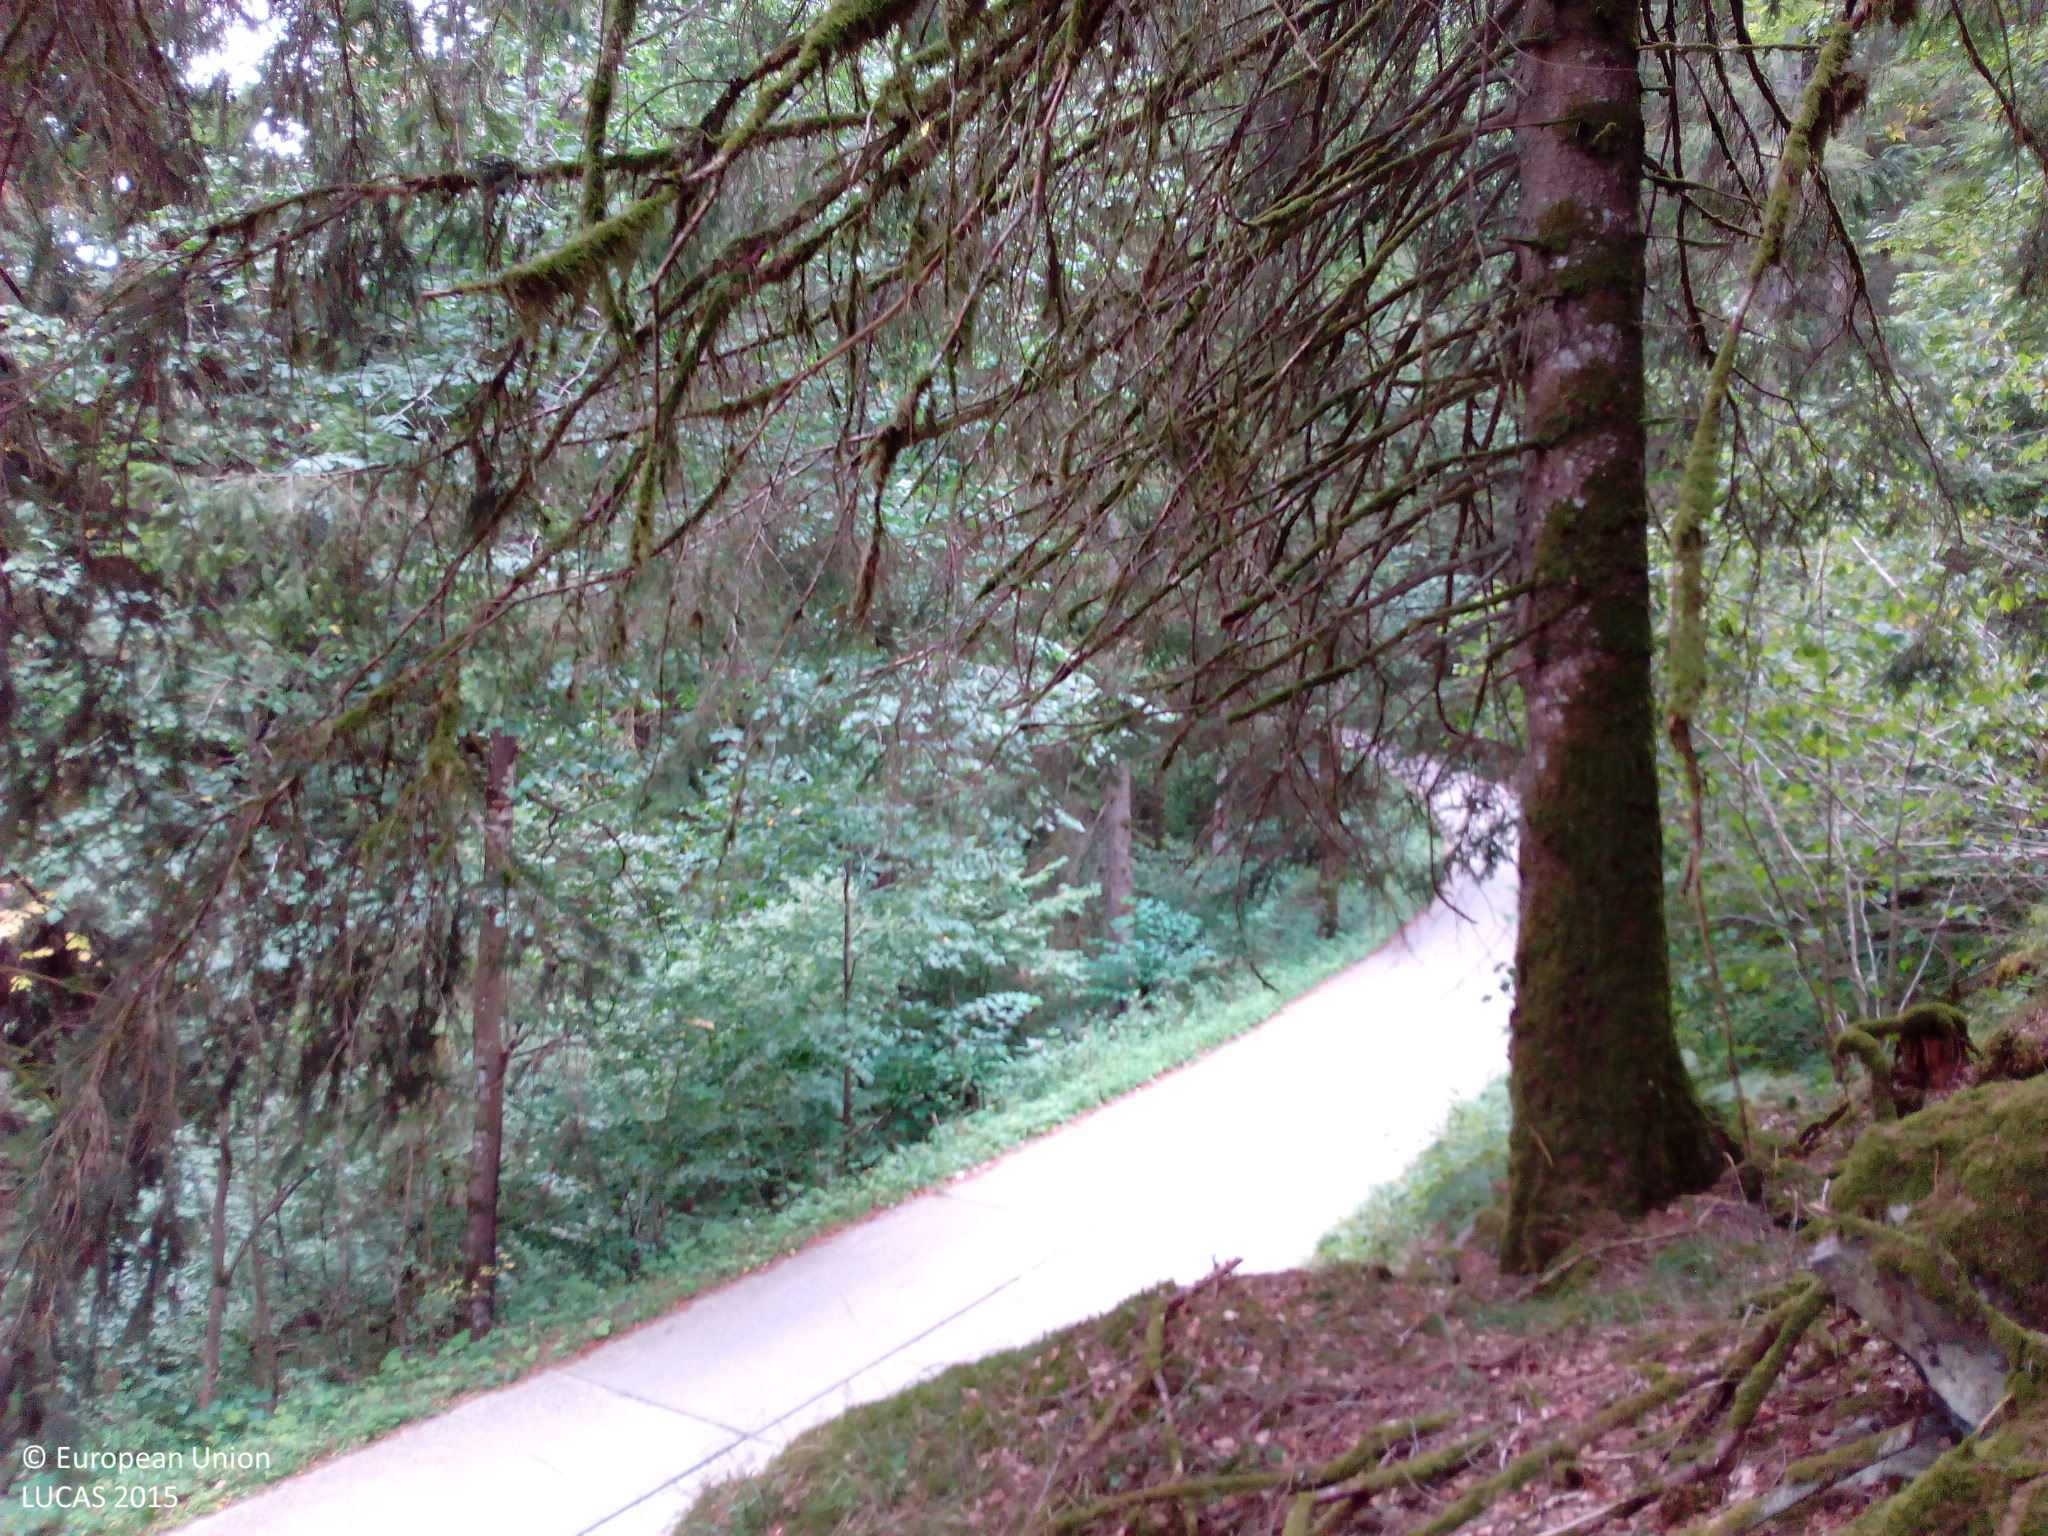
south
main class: Woodland
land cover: Spruce dominated mixed woodland
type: mesophytic deciduous forest
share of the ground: > 75 %
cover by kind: coniferous forest trees 50 %, broadleaved forest trees 25 %, lichens and mosses 10 %, shrubs 5 %, herbaceous plants 5 %, unconsolidated bare surface 5 %
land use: Forestry
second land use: Amenities, museums, leisure
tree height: > 5 m
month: August
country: DE
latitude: 47.7408
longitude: 8.2009
